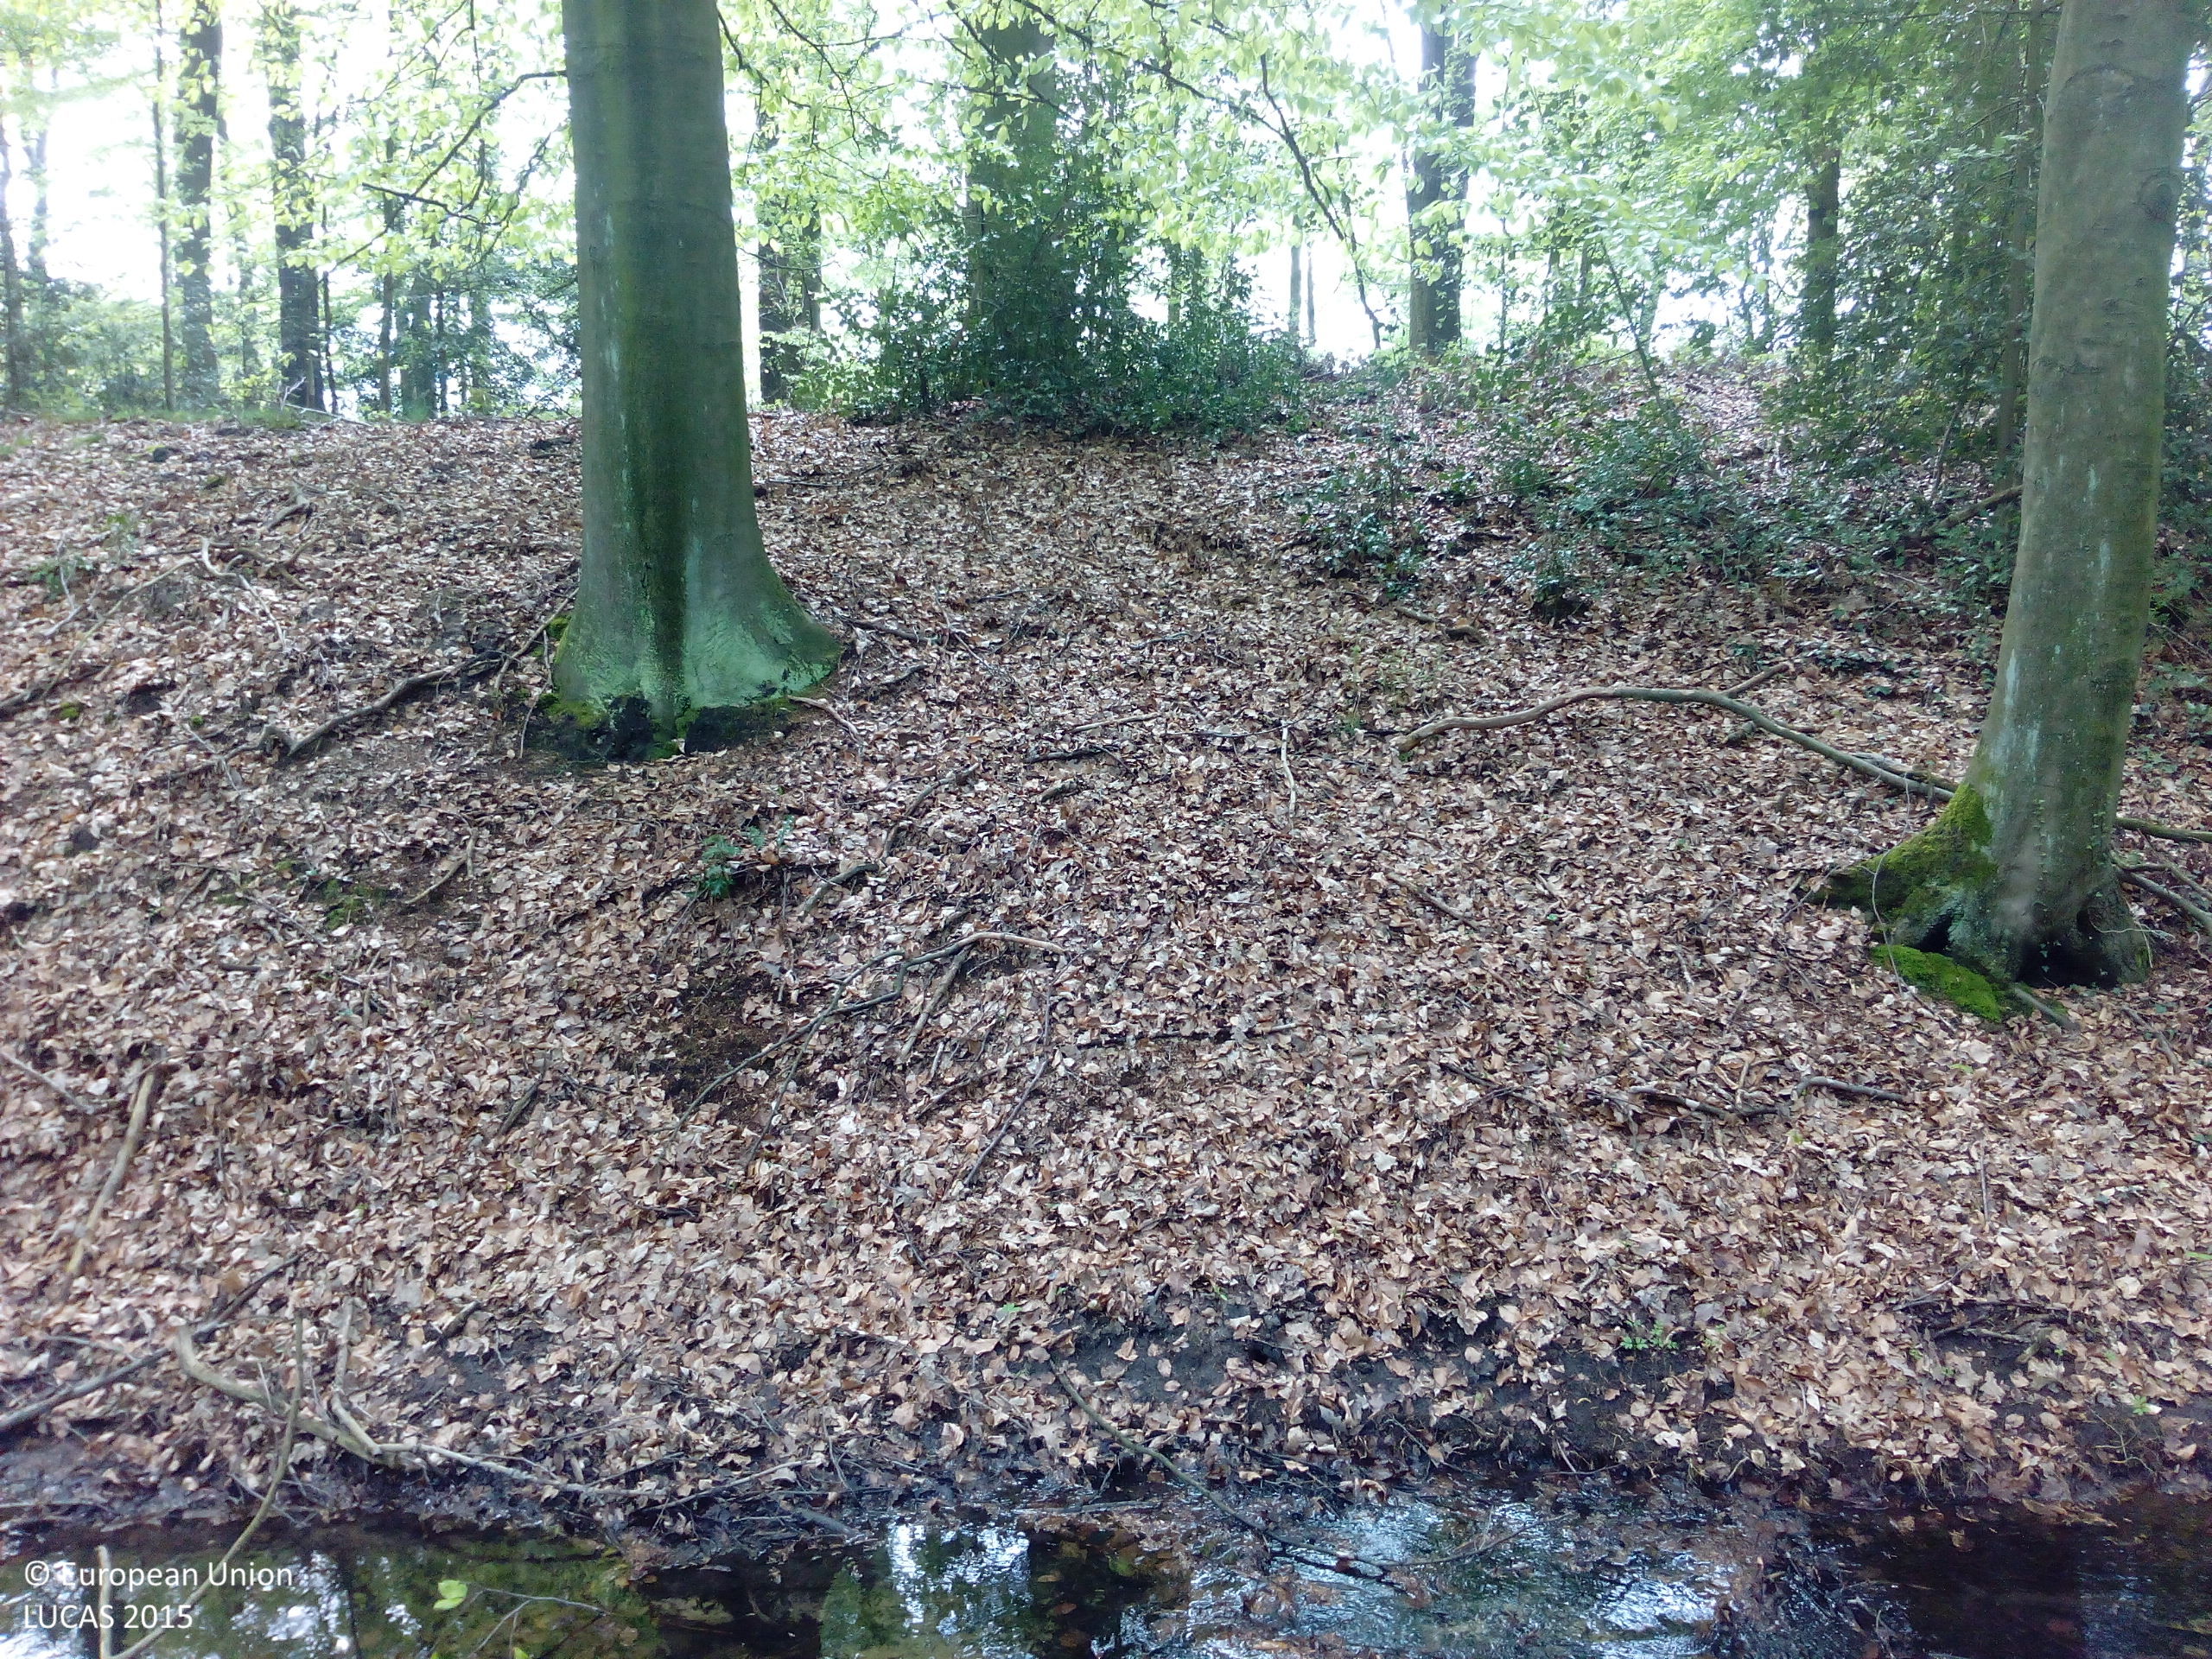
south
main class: Woodland
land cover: Broadleaved woodland
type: mesophytic deciduous forest
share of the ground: > 75 %
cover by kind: broadleaved forest trees 90 %, shrubs 5 %, unconsolidated bare surface 5 %
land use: Forestry
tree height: > 5 m
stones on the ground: < 10 %
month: May
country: DE
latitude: 51.6659
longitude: 7.4122
